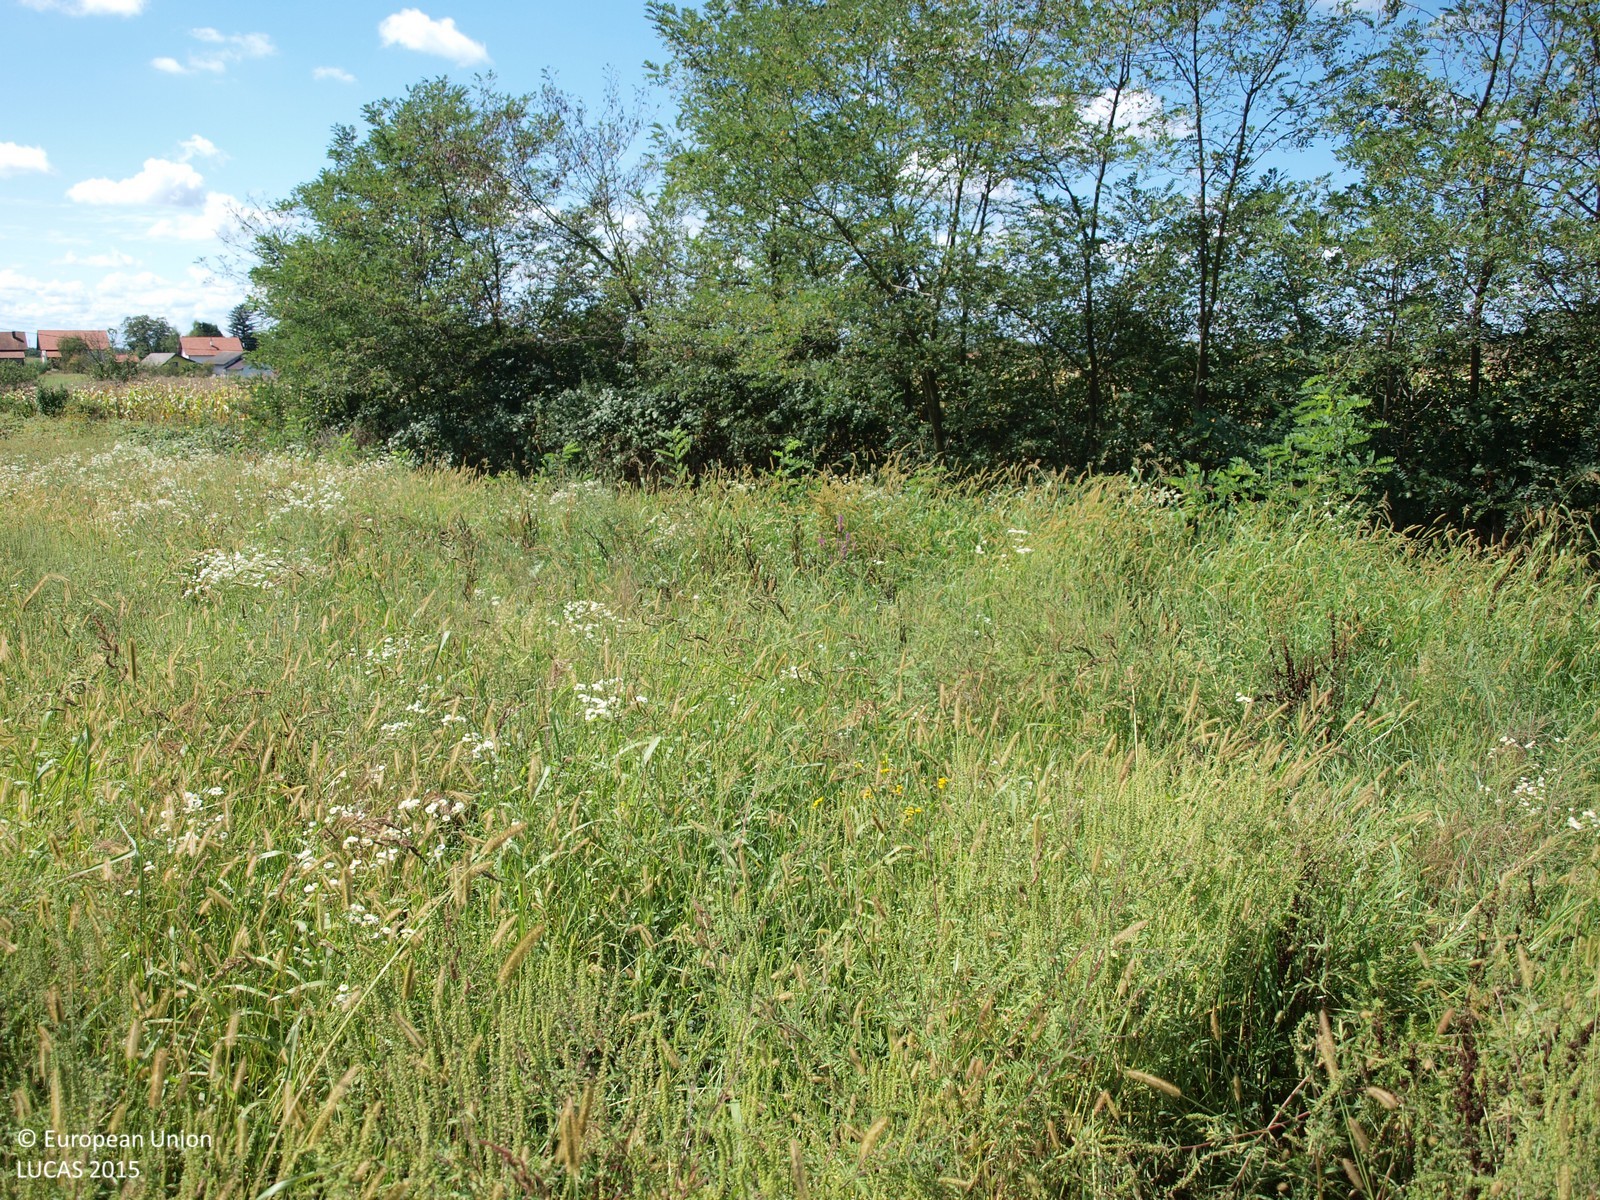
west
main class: Grassland
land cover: Grassland without tree/shrub cover
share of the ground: > 75 %
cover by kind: herbaceous plants 100 %
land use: Agriculture (excluding fallow land and kitchen gardens)
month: September
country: HR
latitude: 45.7432
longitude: 16.4124
